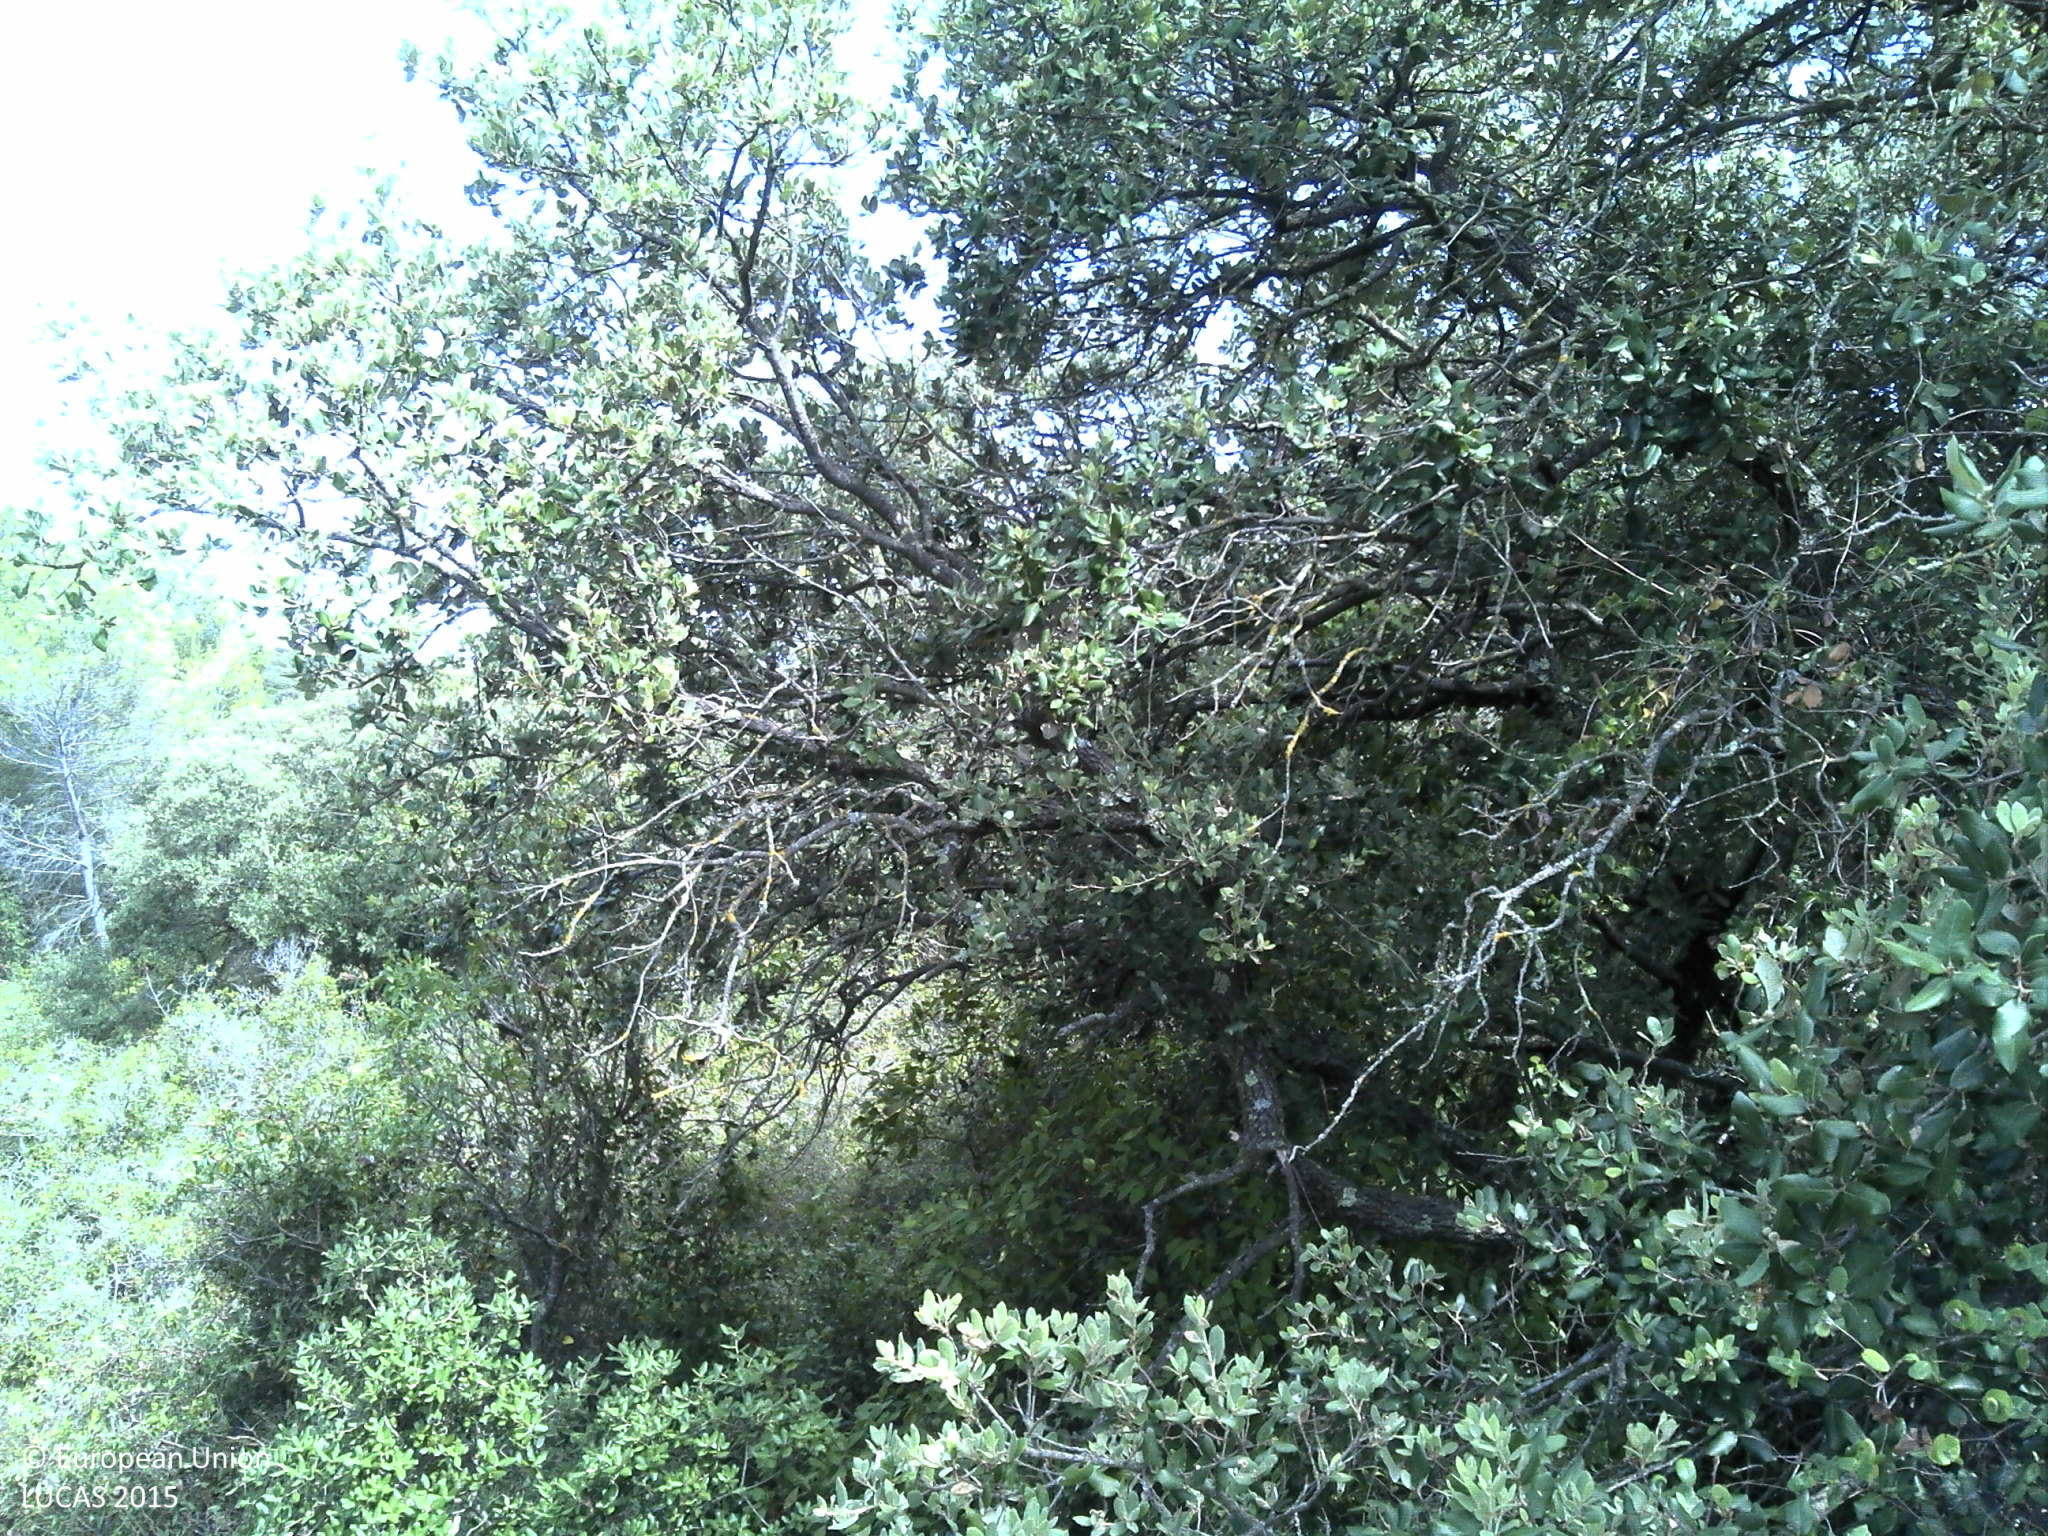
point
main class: Woodland
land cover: Broadleaved woodland
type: broadleaved evergreen forest
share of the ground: > 75 %
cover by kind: broadleaved forest trees 55 %, coniferous forest trees 15 %, shrubs 15 %, herbaceous plants 5 %, consolidated bare surface 5 %, unconsolidated bare surface 5 %
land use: Semi-natural and natural areas not in use
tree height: > 5 m
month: July
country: FR
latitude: 43.4666
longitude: 3.6190
